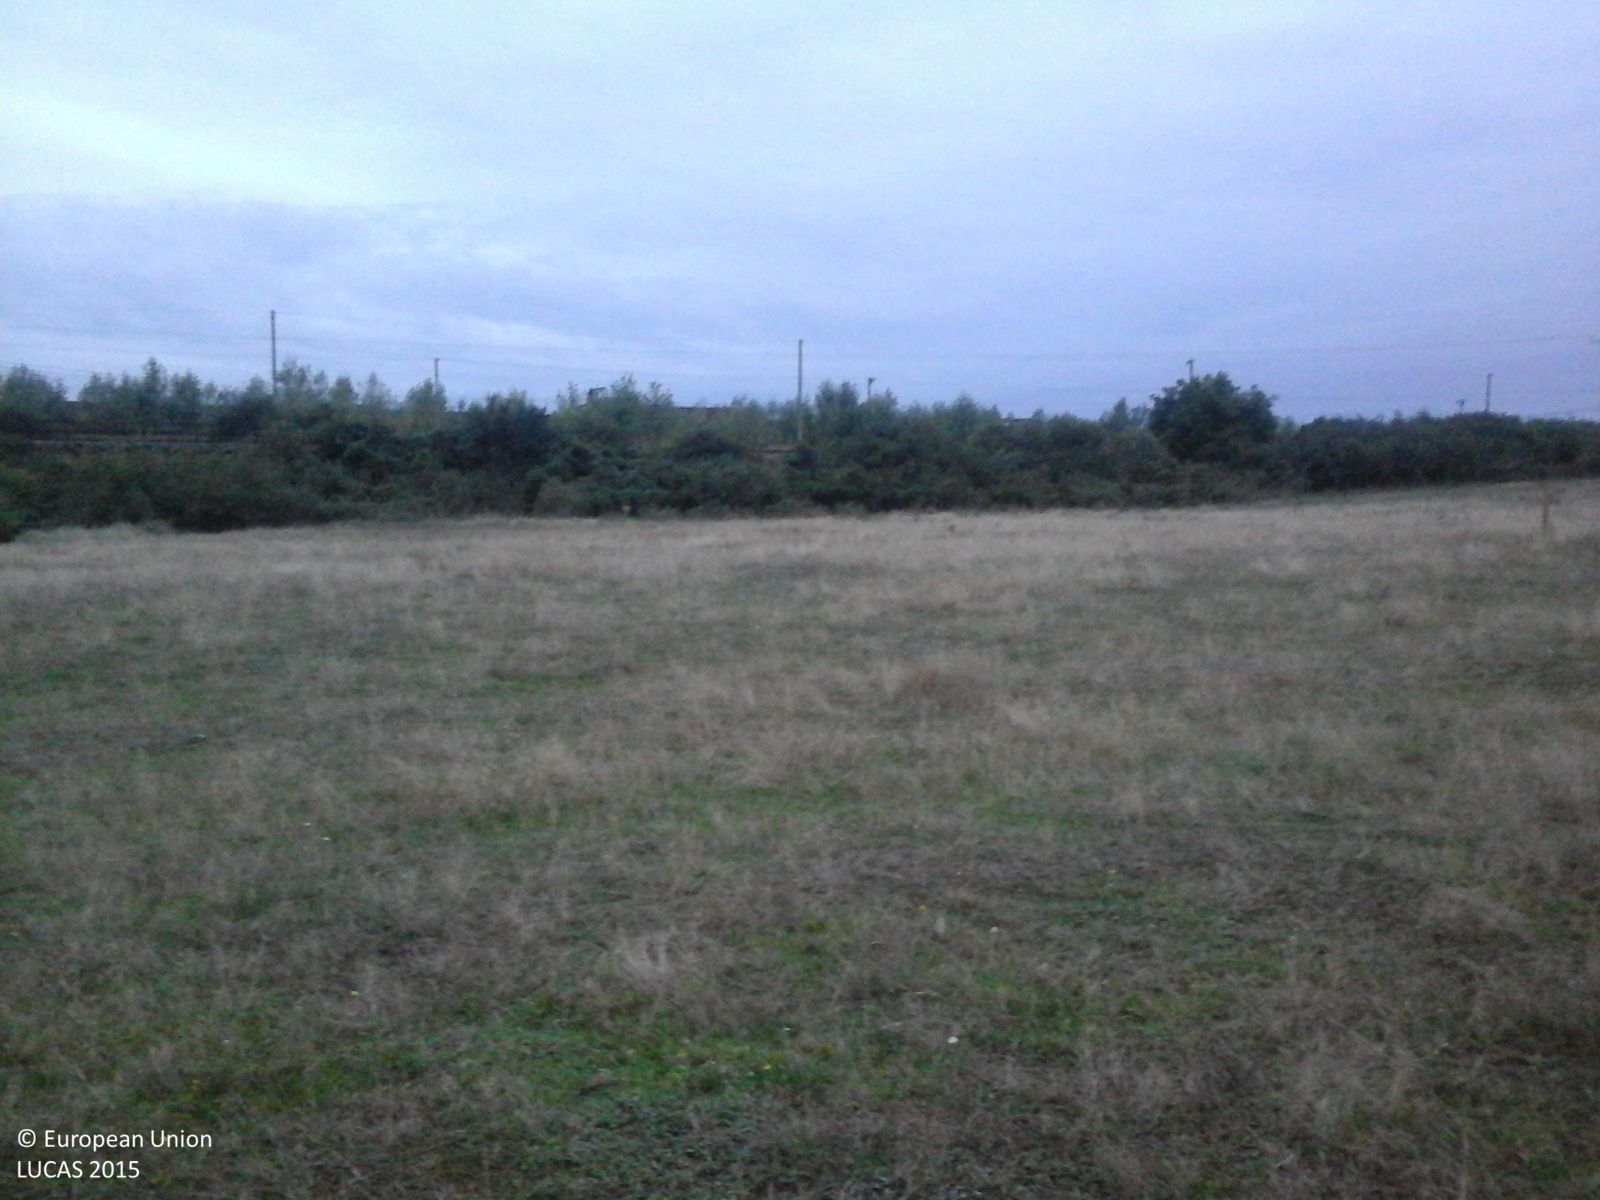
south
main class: Grassland
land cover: Grassland without tree/shrub cover
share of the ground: > 75 %
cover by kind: herbaceous plants 100 %
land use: Agriculture (excluding fallow land and kitchen gardens)
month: September
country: RO
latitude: 47.0366
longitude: 22.0099
